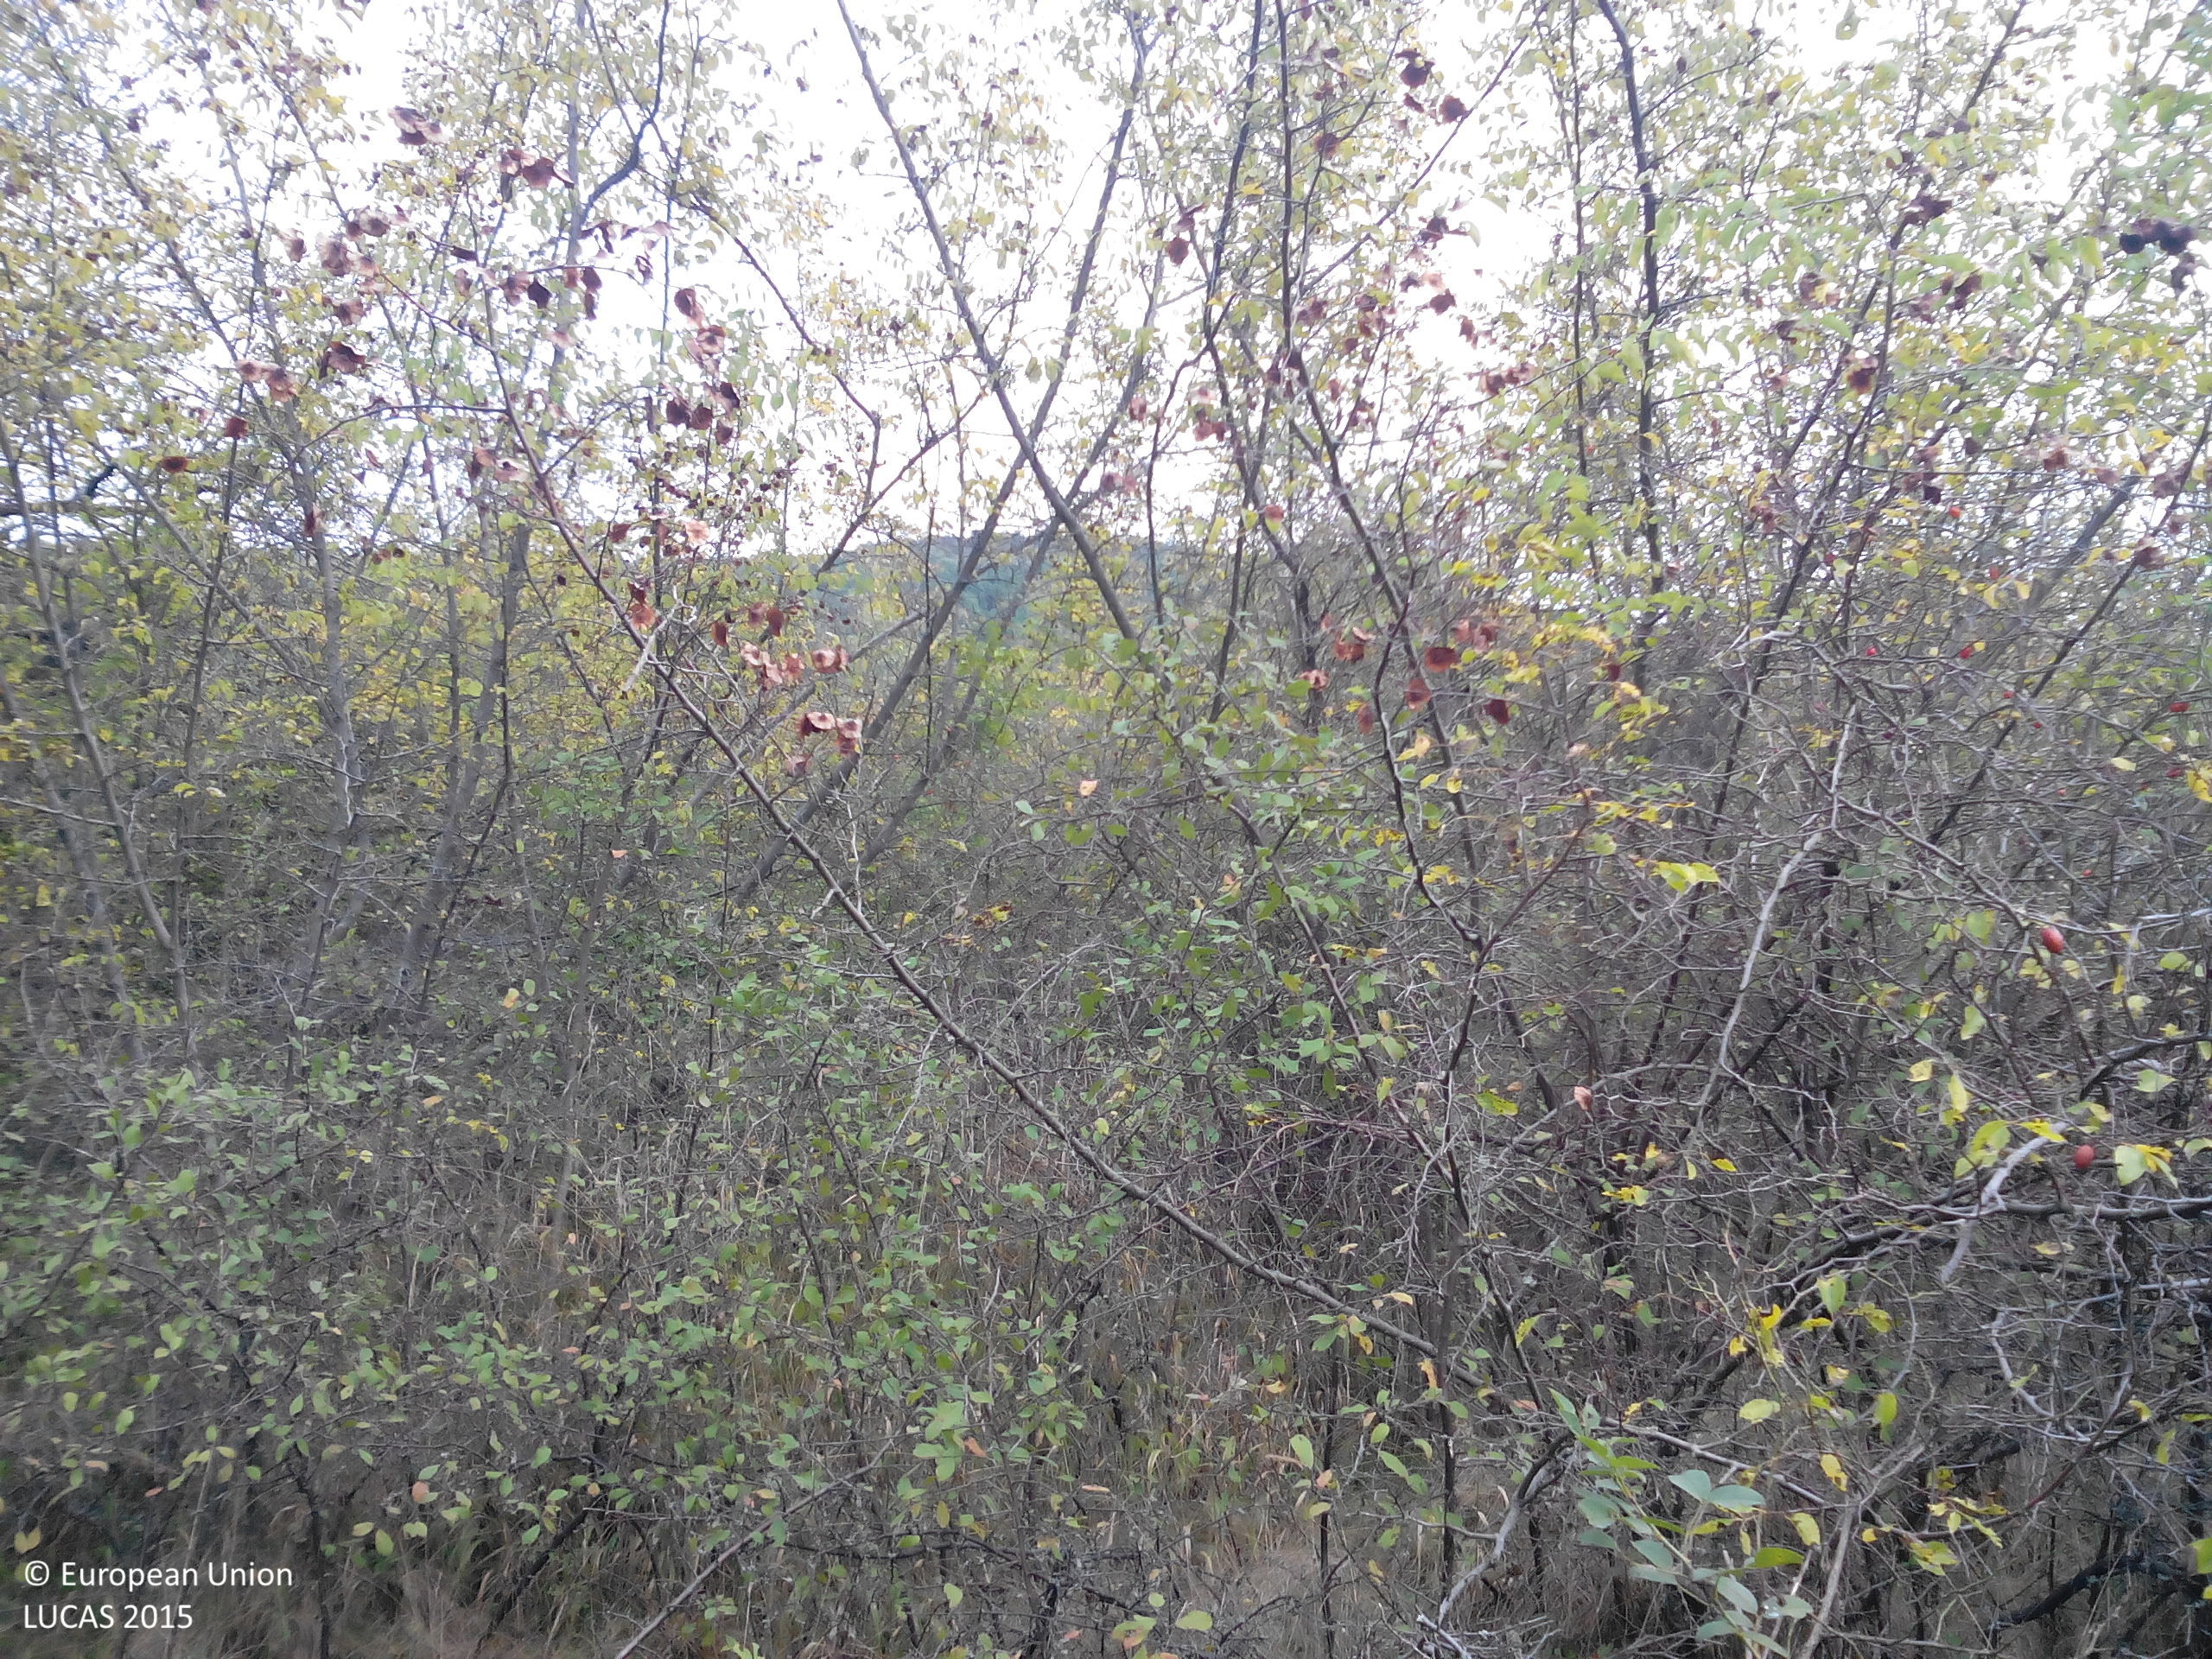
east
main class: Woodland
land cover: Broadleaved woodland
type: mesophytic deciduous forest
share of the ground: 50 - 75 %
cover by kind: broadleaved forest trees 70 %, shrubs 15 %, herbaceous plants 15 %
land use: Forestry
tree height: > 5 m
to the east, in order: Broadleaved woodland; Grassland with sparse tree/shrub cover; Broadleaved woodland
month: October
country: BG
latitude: 43.2423
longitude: 24.0536
